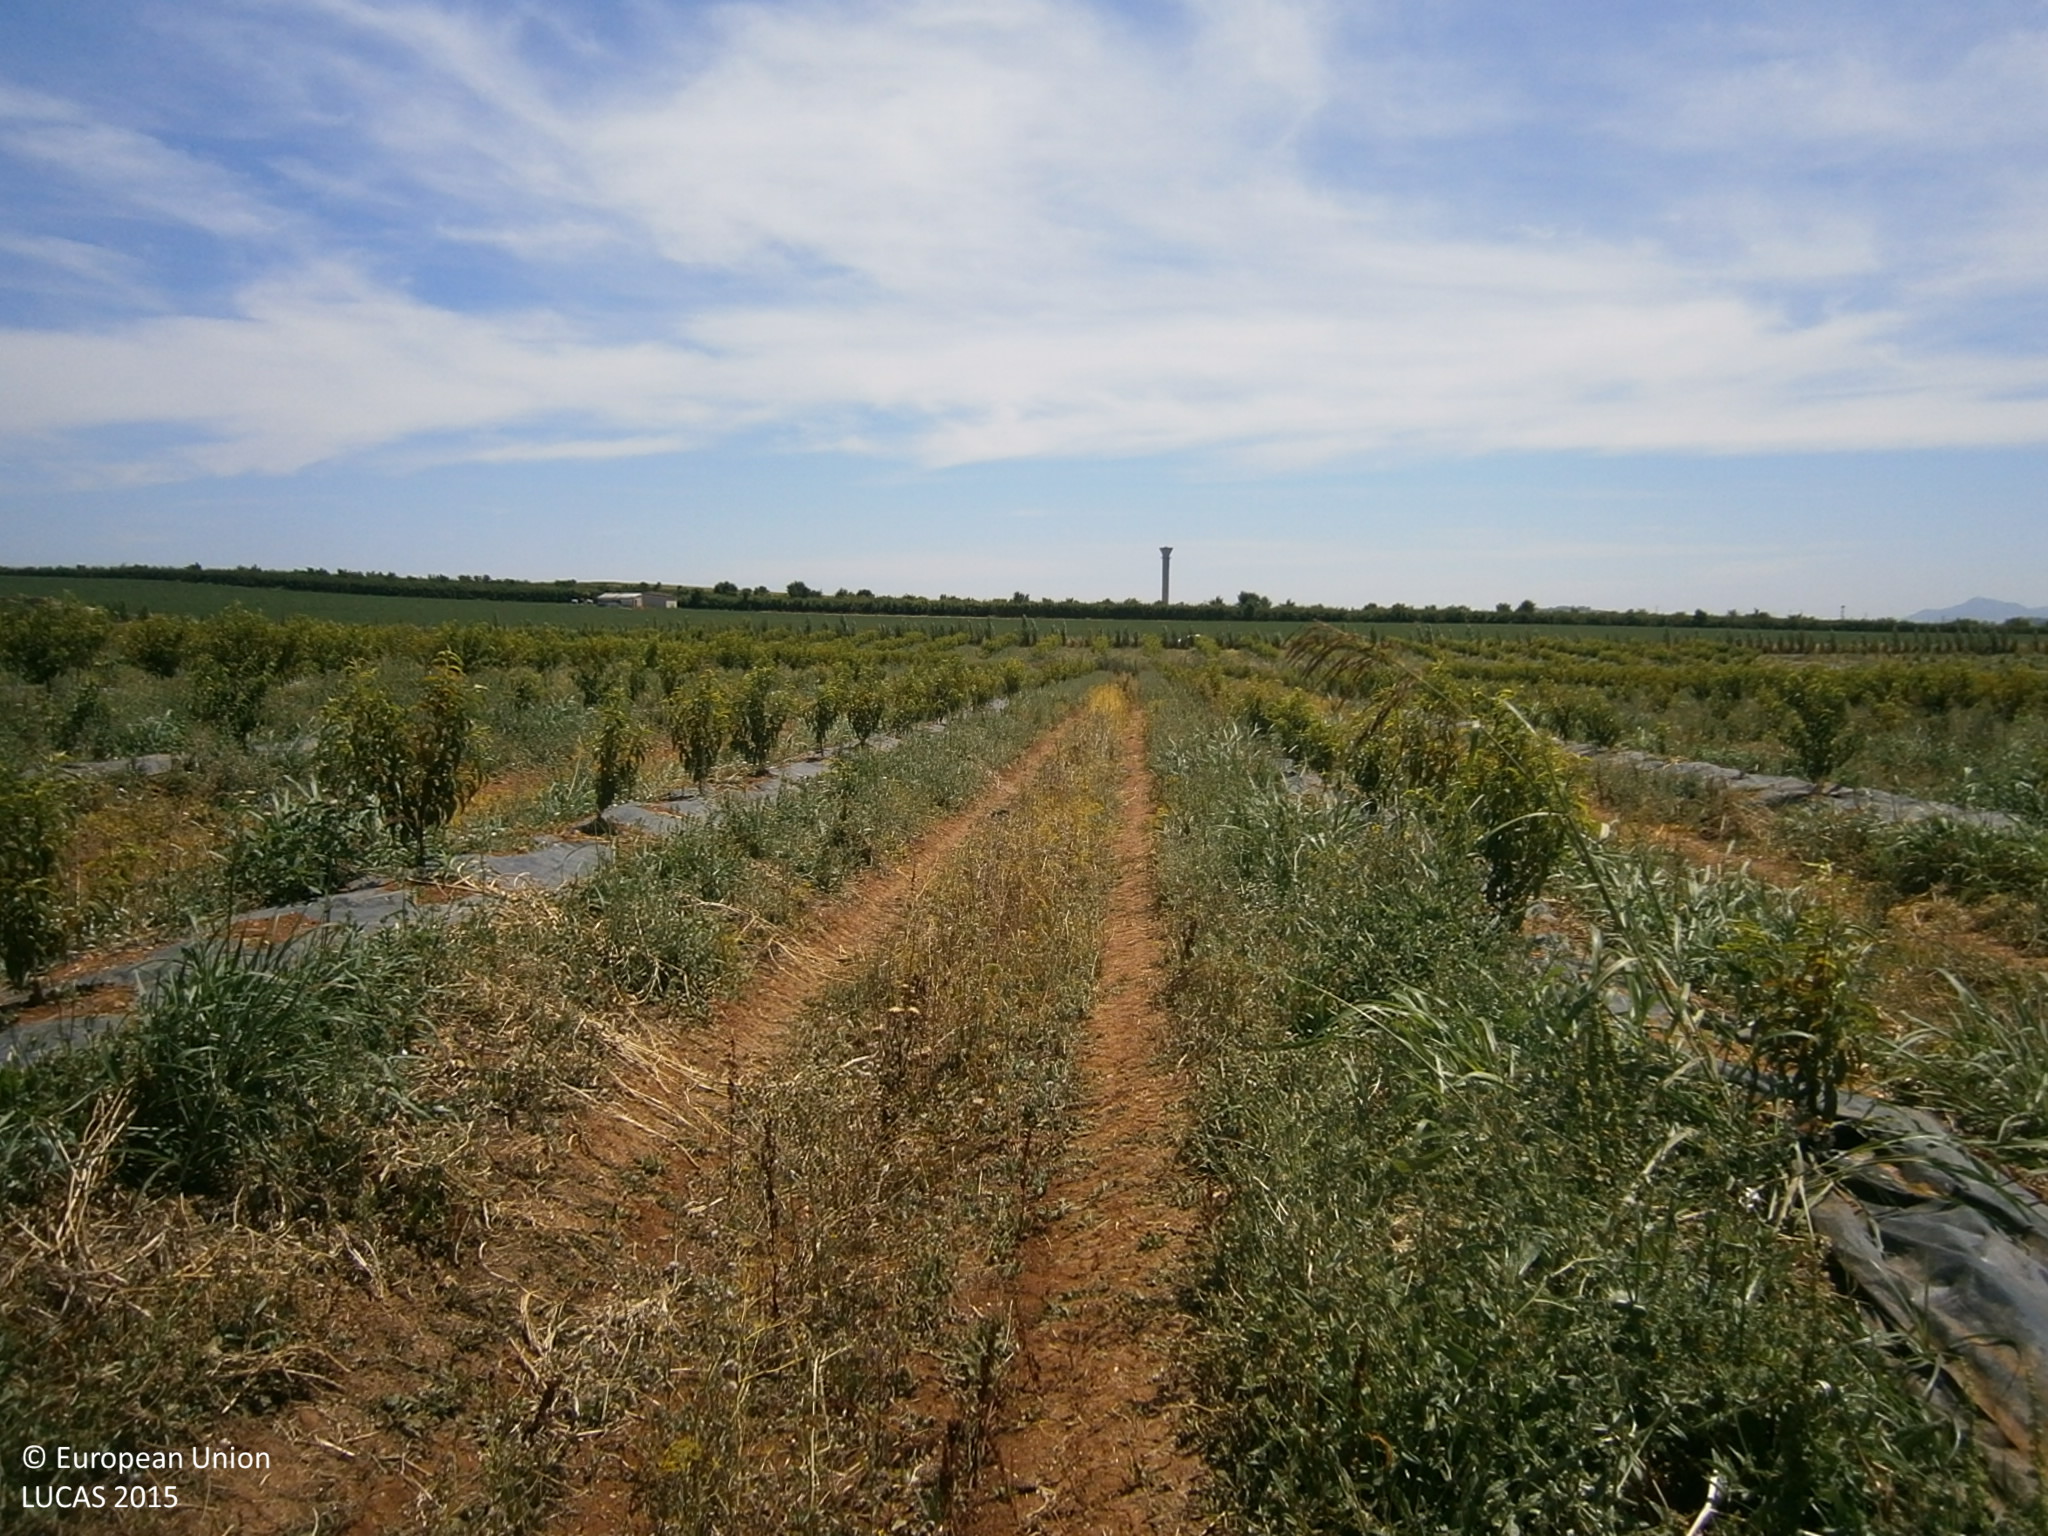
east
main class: Cropland
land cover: Other fruit trees and berries
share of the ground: 50 - 75 %
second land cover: Spontaneously vegetated surfaces
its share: 10 - 25 %
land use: Agriculture (excluding fallow land and kitchen gardens)
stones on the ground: < 10 %
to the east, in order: Other fruit trees and berries; Spontaneously vegetated surfaces; Rivers and streams; Other fruit trees and berries; Fences; Tracks; Tomatoes
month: June
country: ES
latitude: 38.9370
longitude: -6.6890
